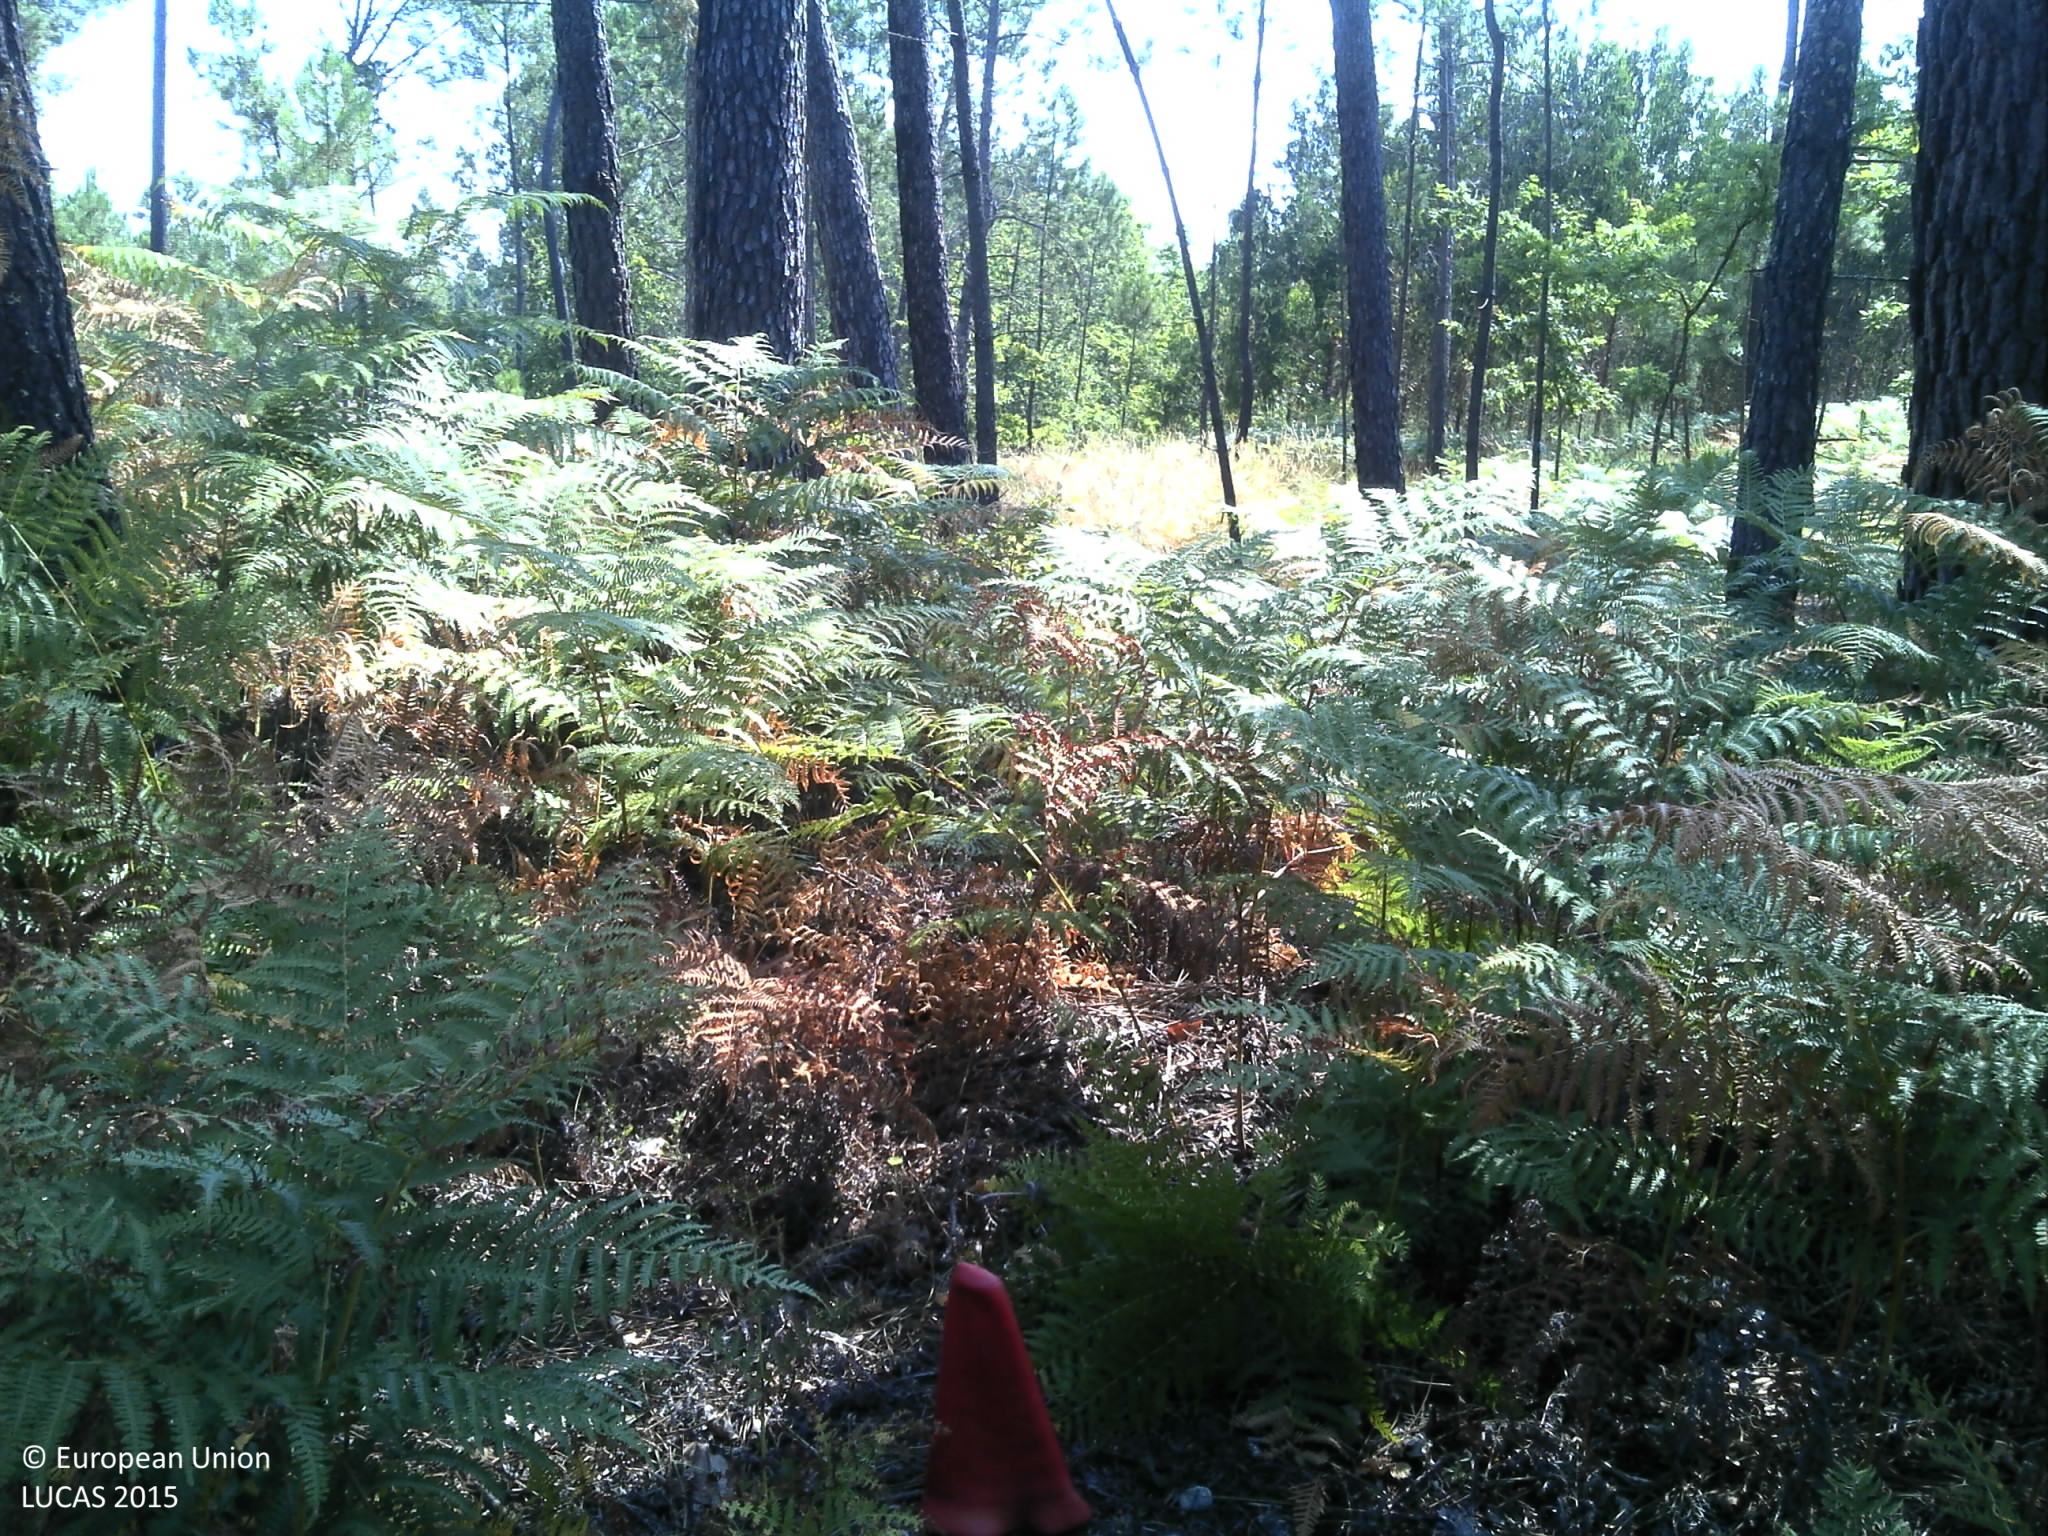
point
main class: Woodland
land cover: Pine dominated coniferous woodland
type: coniferous forest of the mediterranean region
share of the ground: 50 - 75 %
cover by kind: coniferous forest trees 60 %, shrubs 15 %, consolidated bare surface 10 %, unconsolidated bare surface 10 %, herbaceous plants 5 %
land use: Forestry
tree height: > 5 m
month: July
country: PT
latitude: 40.4294
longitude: -8.0286
